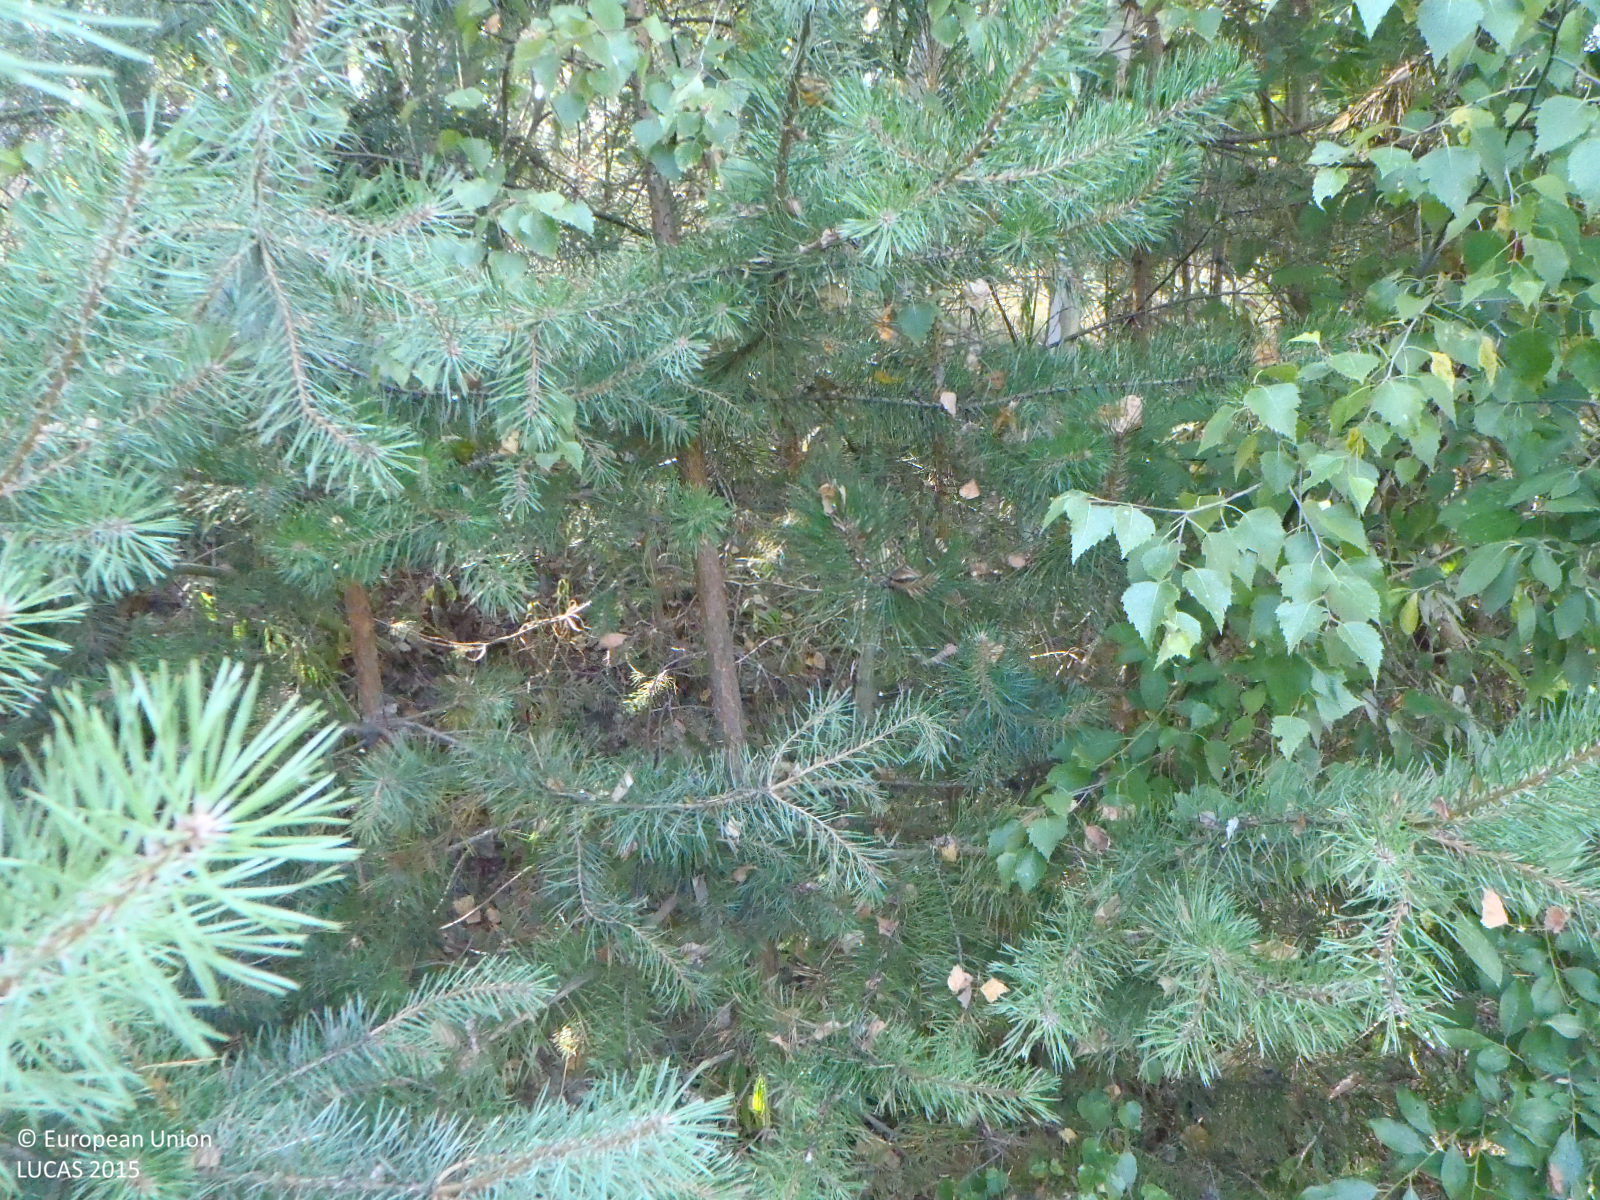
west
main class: Grassland
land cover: Spontaneously vegetated surfaces
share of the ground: > 75 %
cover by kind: herbaceous plants 95 %, unconsolidated bare surface 5 %
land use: Community services
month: August
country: CZ
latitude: 50.6700
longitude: 14.5438
